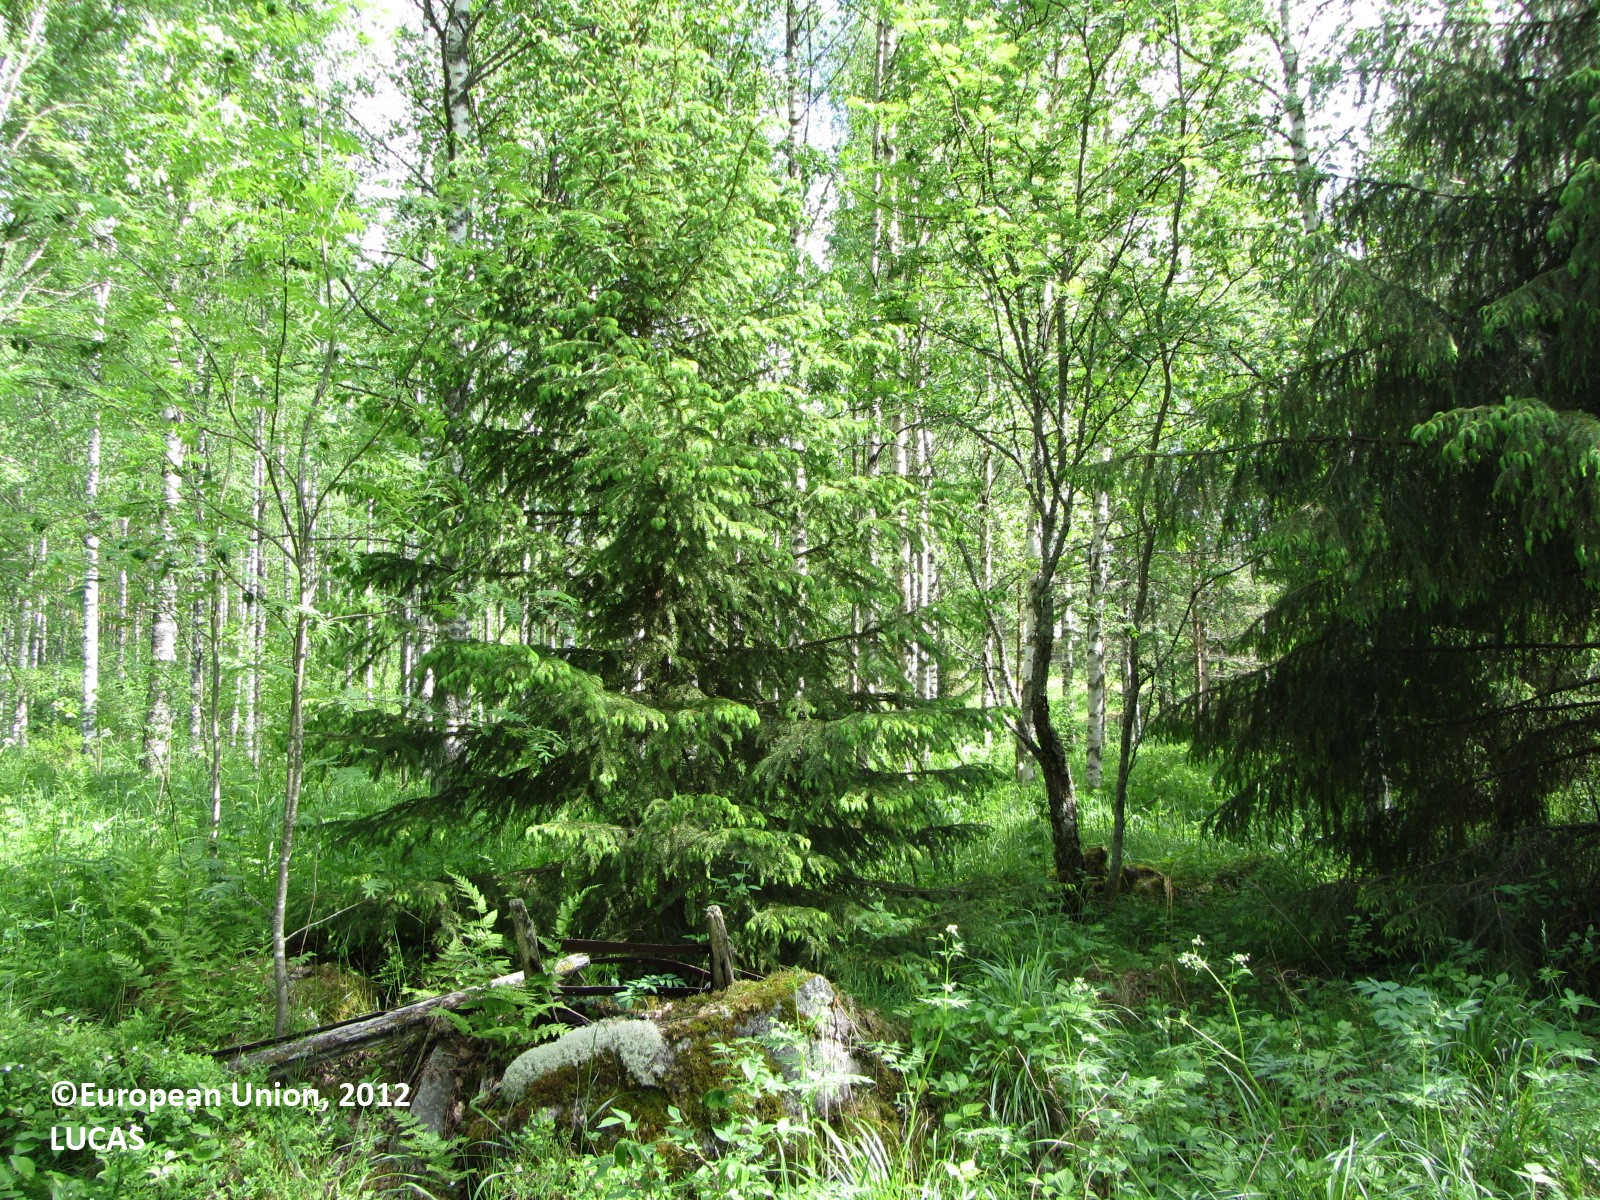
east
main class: Woodland
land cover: Broadleaved woodland
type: hemiboreal forest and nemoral coniferous forest and mixed broadleaved-coniferous forest
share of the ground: 50 - 75 %
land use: Forestry
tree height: > 5 m
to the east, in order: Broadleaved woodland; Tracks; Ditches and canals; Broadleaved woodland; Ditches and canals; Broadleaved woodland; Grassland with sparse tree/shrub cover; Rock outcrops; Other mixed woodland; Spruce dominated coniferous woodland; Other mixed woodland; Shrubland with sparse tree cover; Other mixed woodland
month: June
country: FI
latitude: 61.9613
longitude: 25.0376
